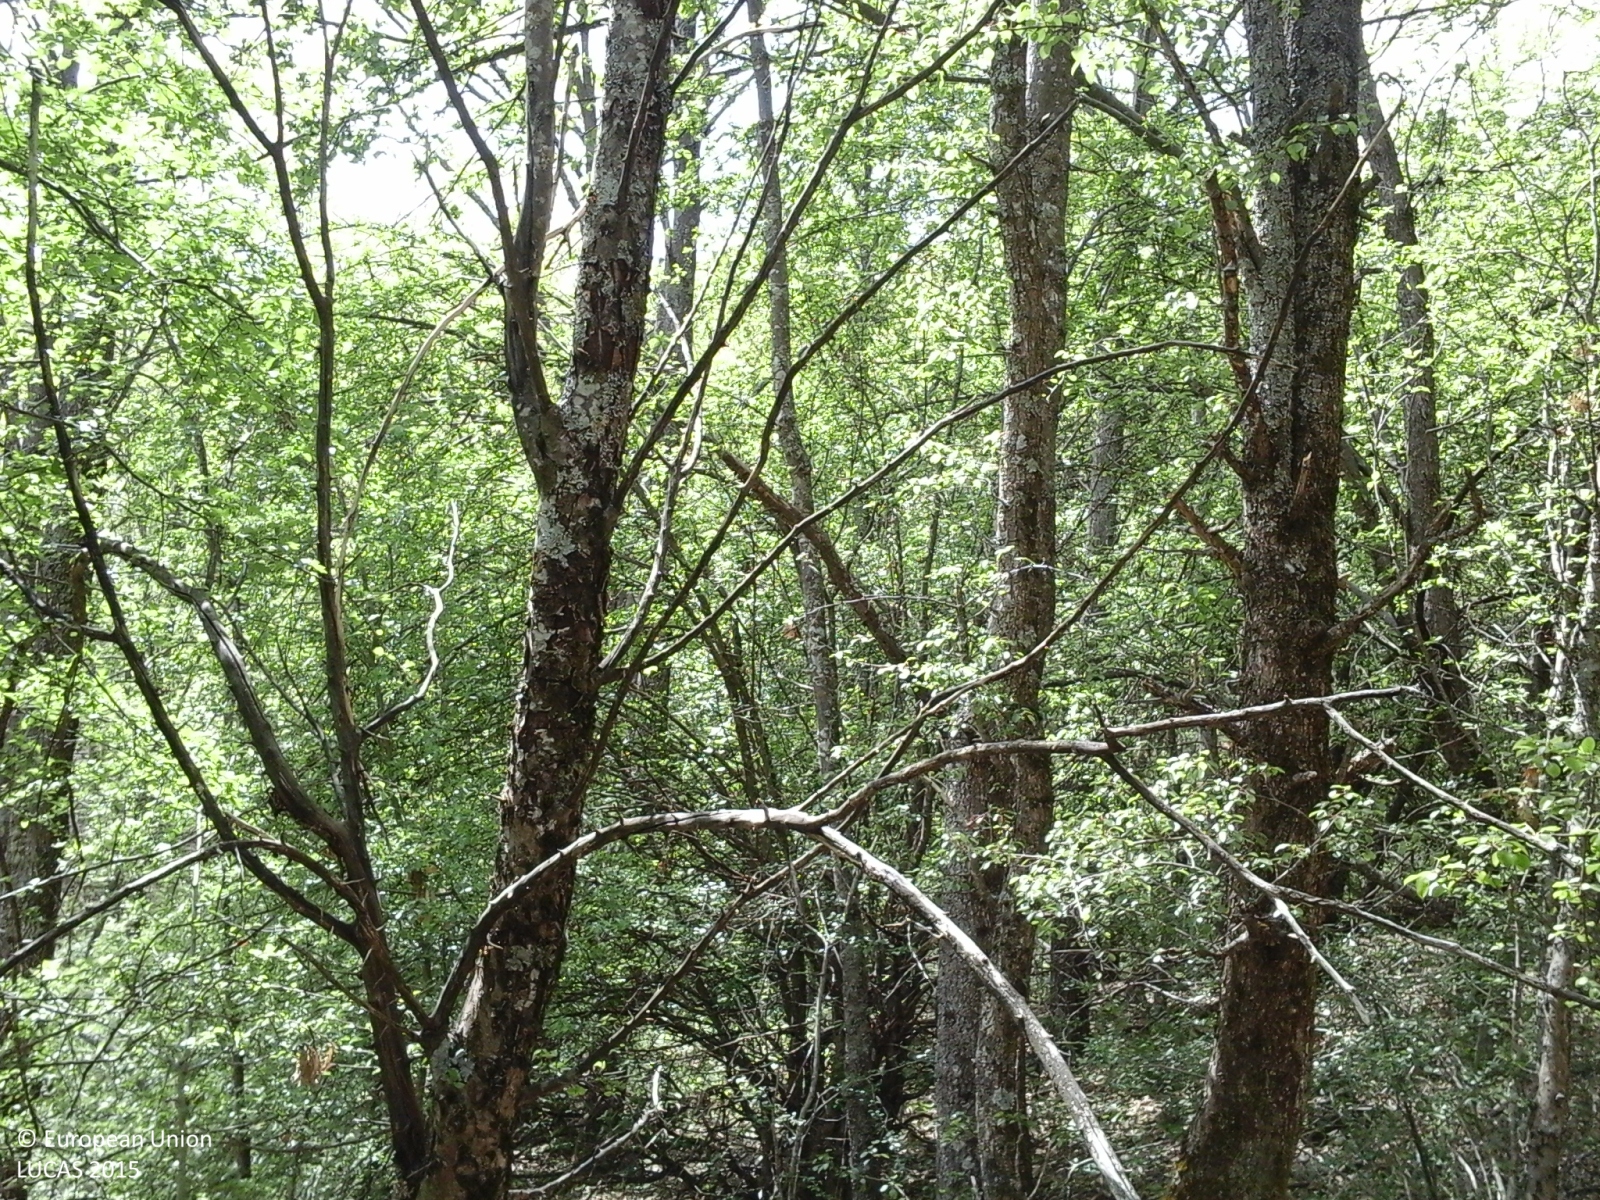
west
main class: Woodland
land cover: Other mixed woodland
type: thermophilous deciduous forest
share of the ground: > 75 %
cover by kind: broadleaved forest trees 50 %, coniferous forest trees 25 %, shrubs 25 %
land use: Forestry
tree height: > 5 m
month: May
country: IT
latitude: 44.6191
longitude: 9.3587
